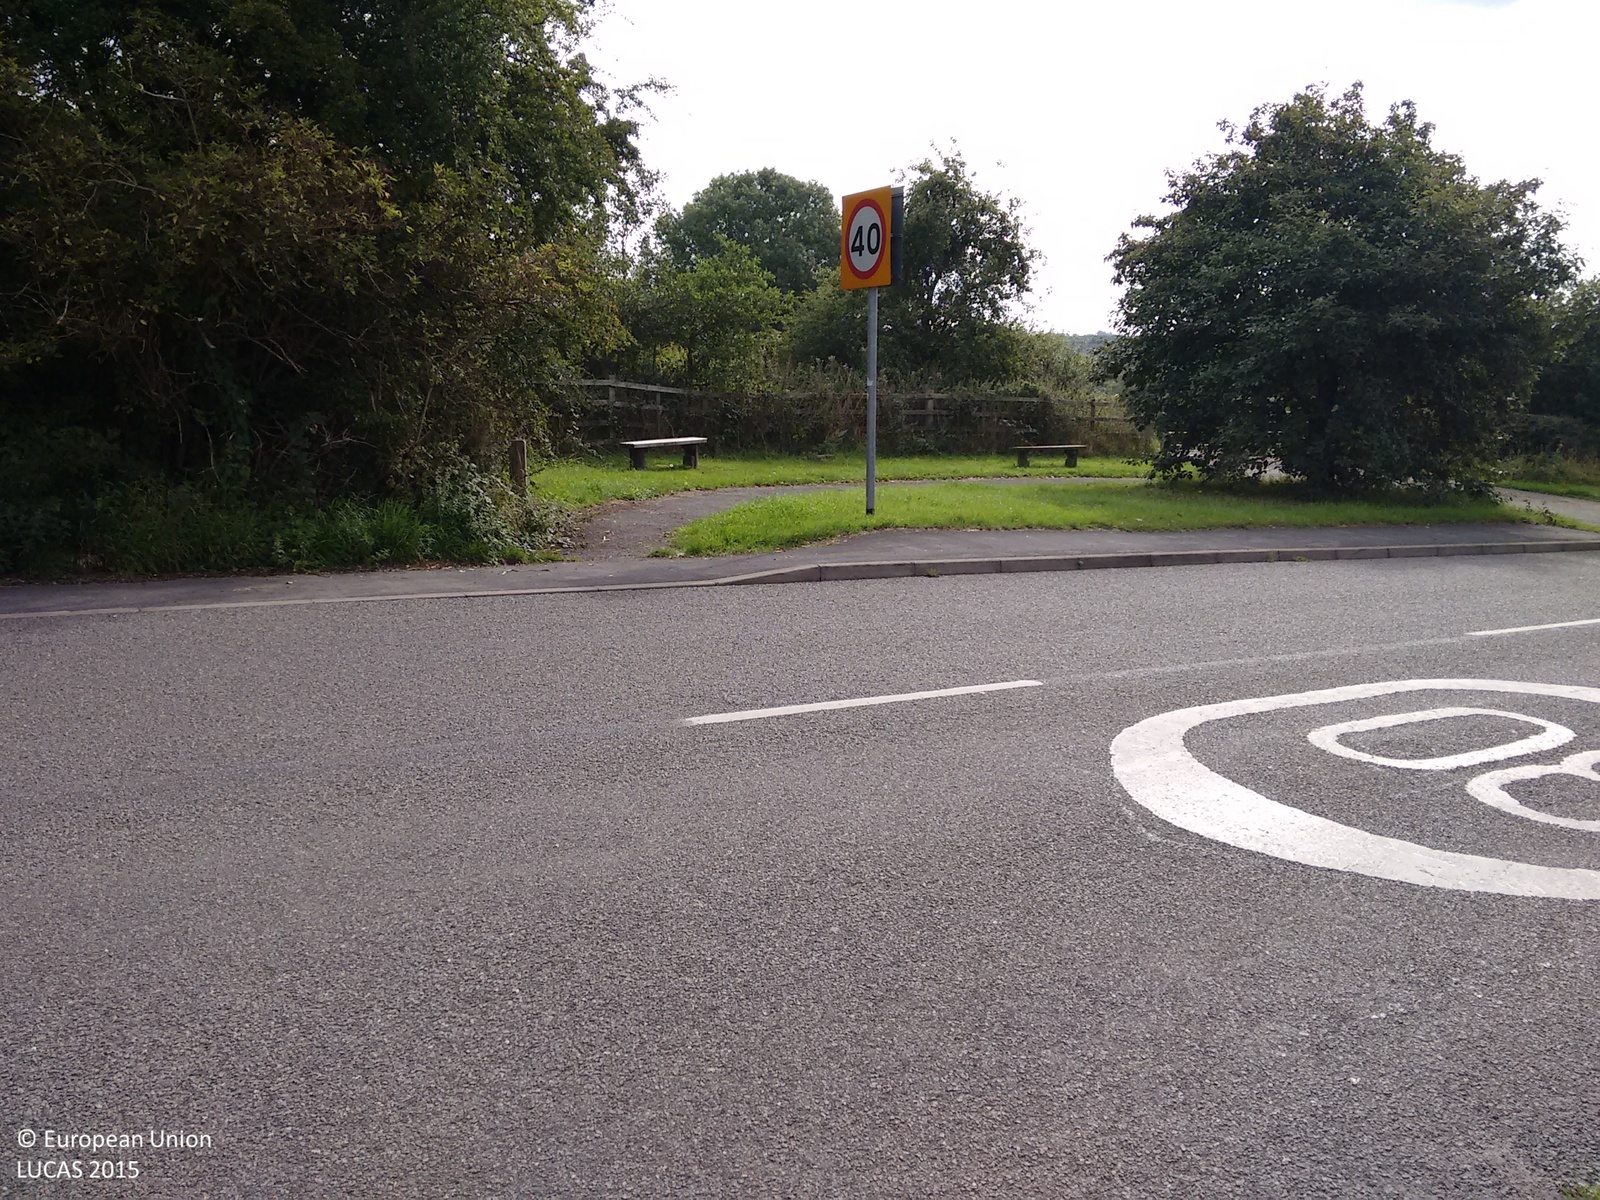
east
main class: Grassland
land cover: Grassland without tree/shrub cover
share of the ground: > 75 %
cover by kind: herbaceous plants 100 %
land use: Agriculture (excluding fallow land and kitchen gardens)
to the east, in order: Grassland without tree/shrub cover; Ditches and canals; Managed hedges; Fences; Grass margins; Paved roads, cycling and walking lanes; Grass margins; Tracks; Fences; Tracks; Grass margins; Managed hedges; Grass margins; Tracks; Artificial constructions in urban areas; Other bare soil
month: September
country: GB
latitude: 52.7223
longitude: -1.5255
